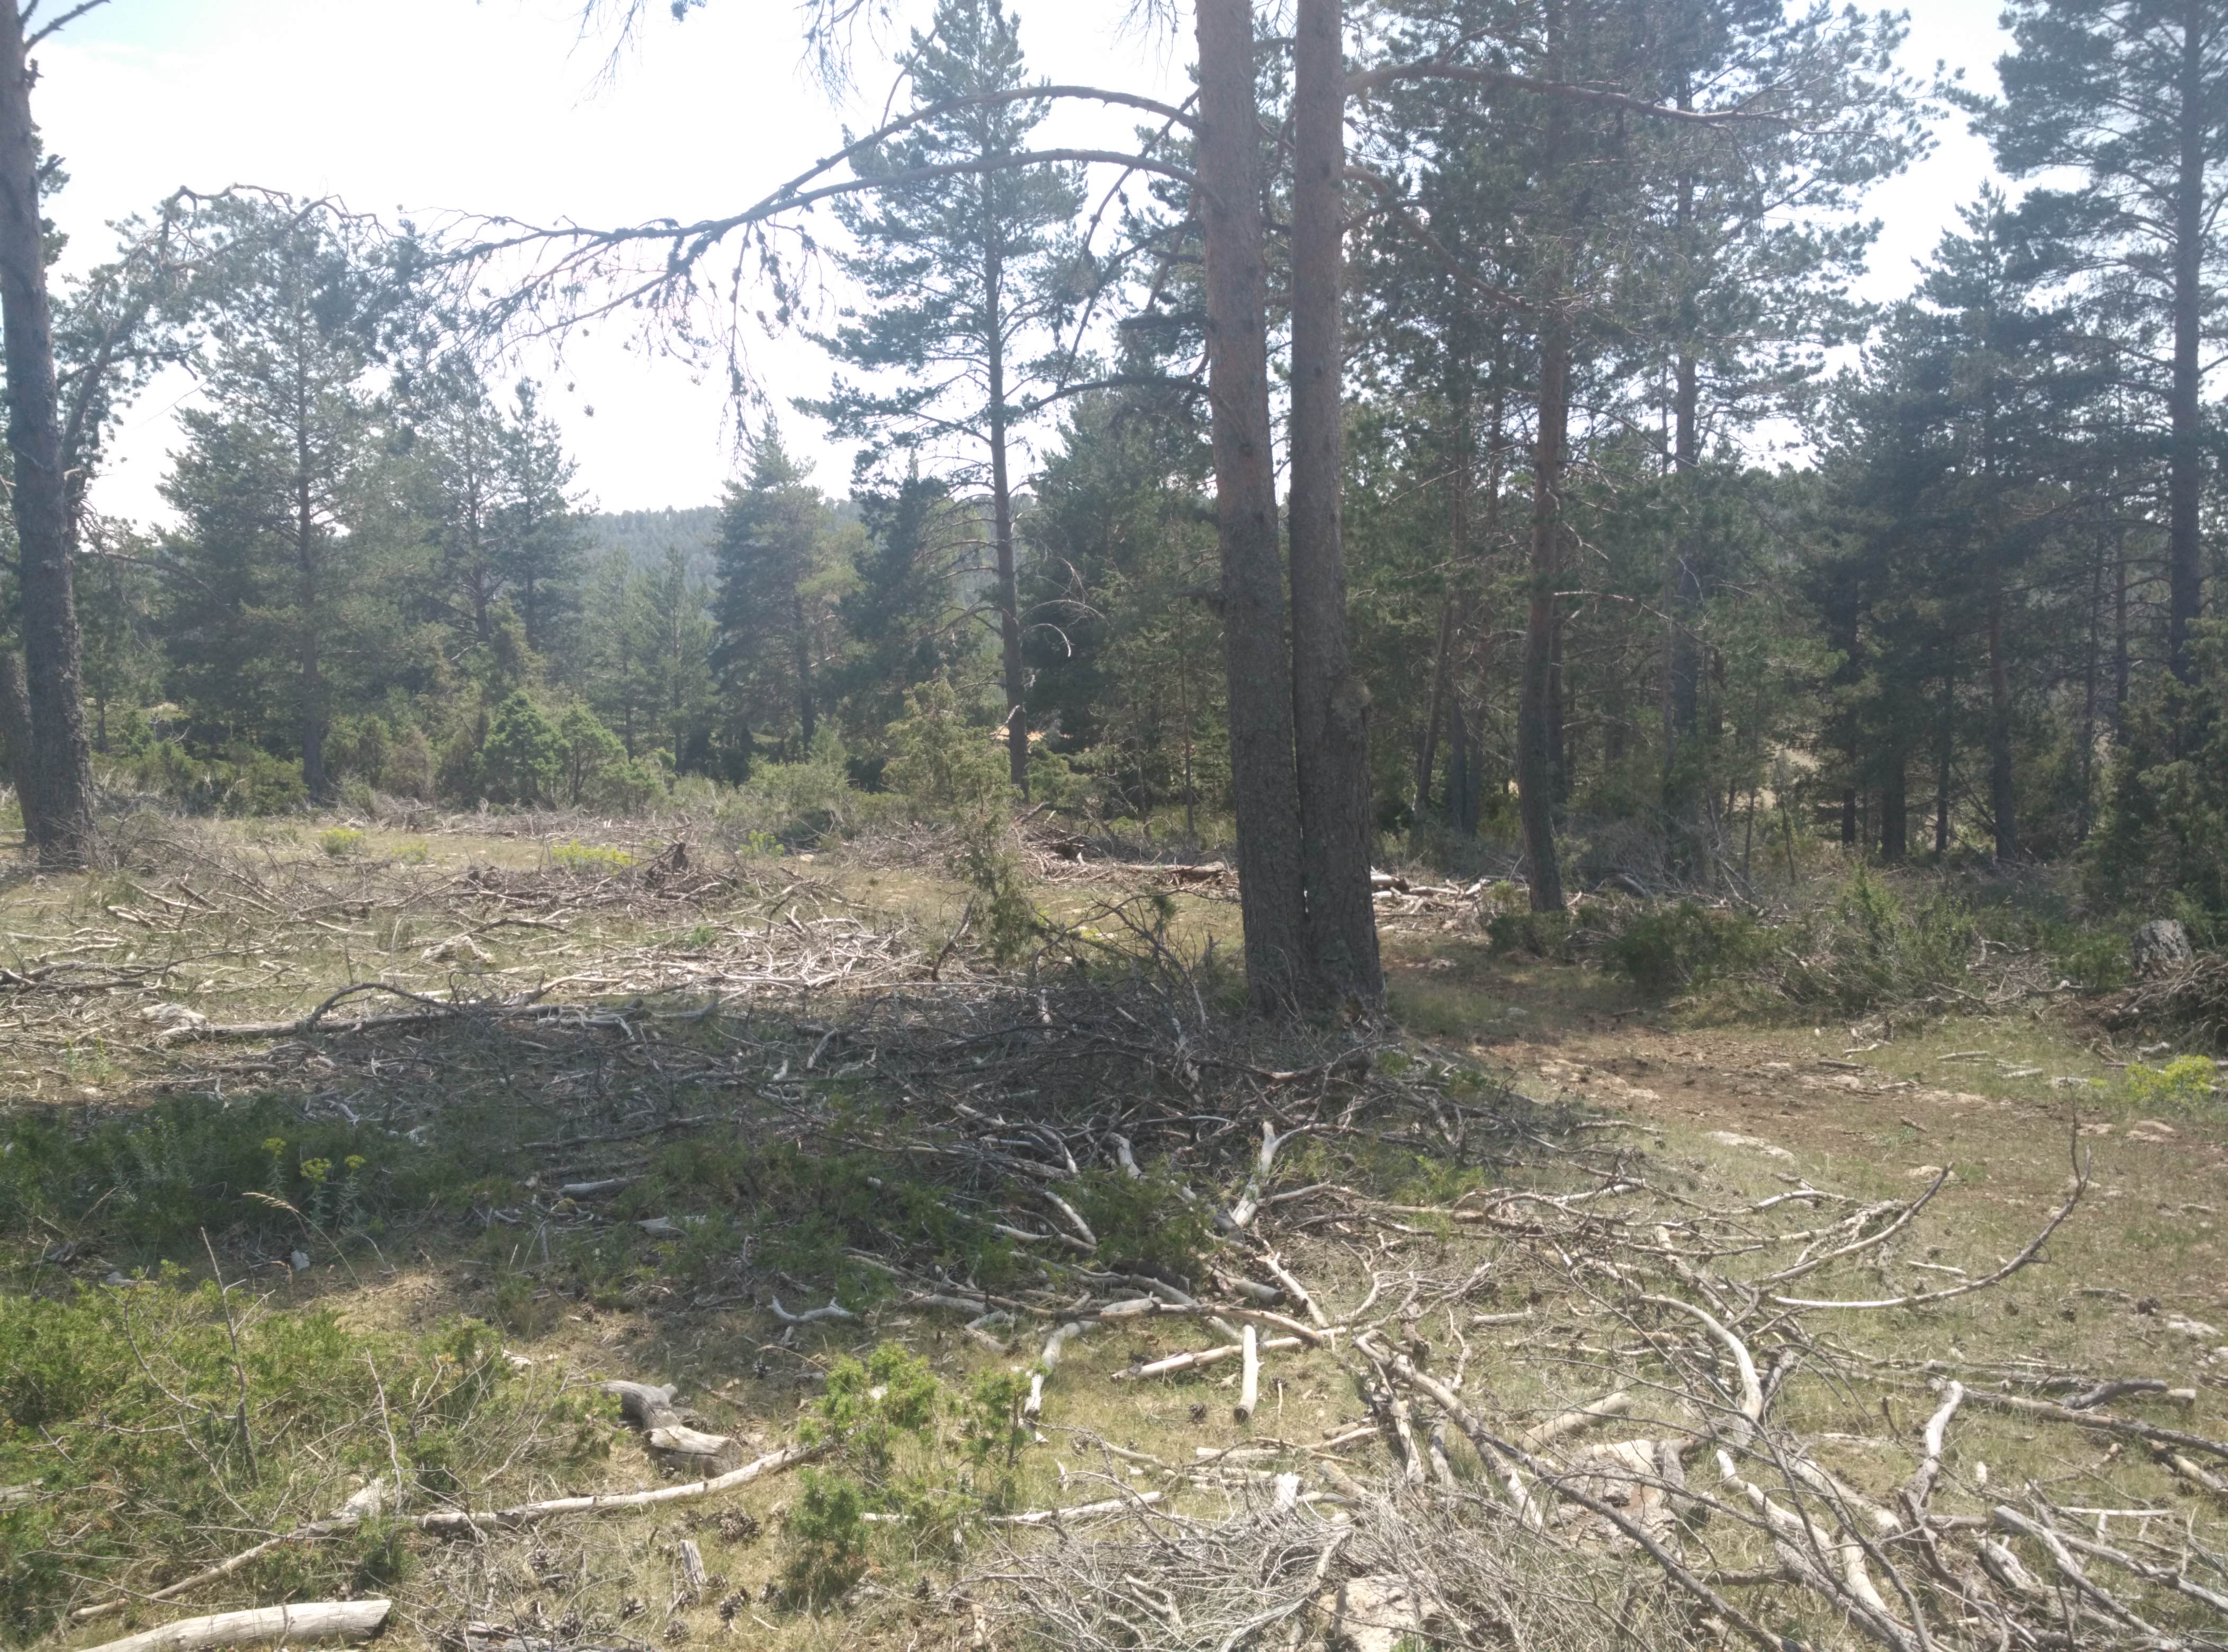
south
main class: Woodland
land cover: Pine dominated coniferous woodland
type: coniferous forest of the mediterranean region
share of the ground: 50 - 75 %
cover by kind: coniferous forest trees 50 %, shrubs 25 %, unconsolidated bare surface 25 %
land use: Semi-natural and natural areas not in use
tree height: > 5 m
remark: Clear cut
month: June
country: ES
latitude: 40.5043
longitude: -1.7827
